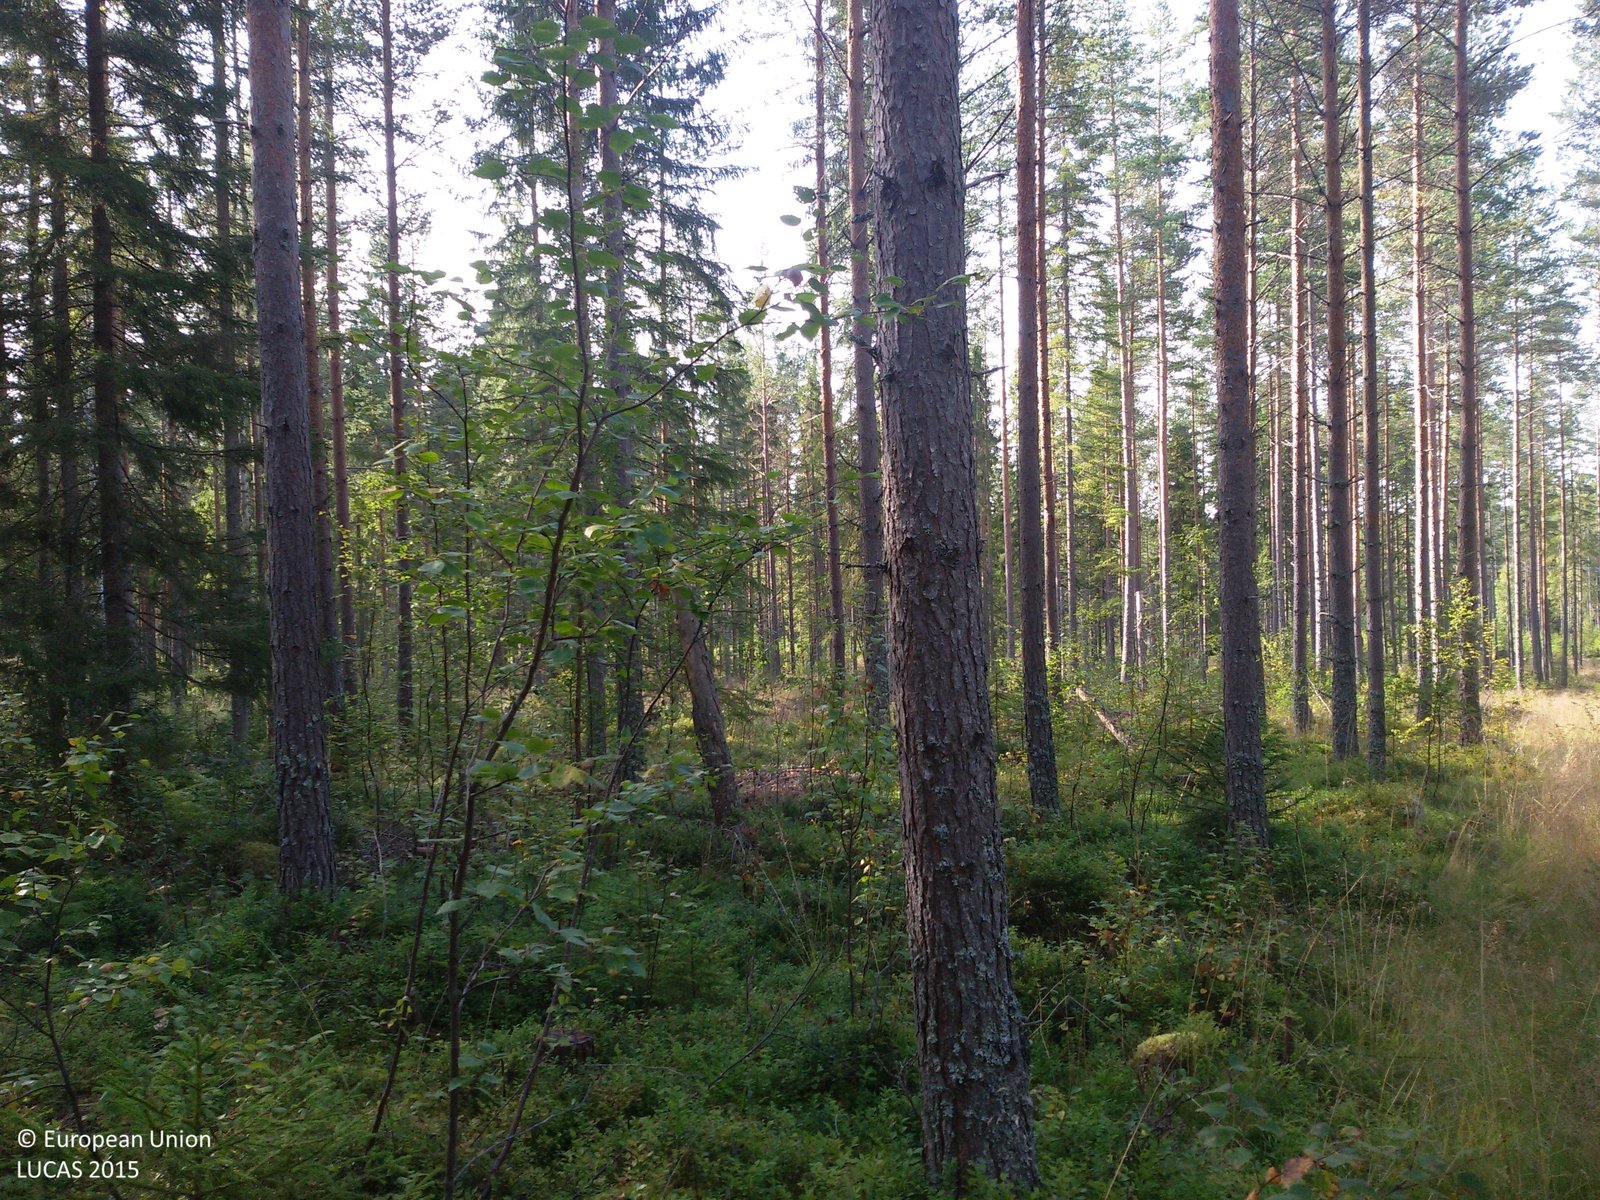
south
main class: Woodland
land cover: Pine dominated coniferous woodland
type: boreal forest
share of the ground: 50 - 75 %
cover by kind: coniferous forest trees 70 %, herbaceous plants 25 %, lichens and mosses 5 %
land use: Forestry
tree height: > 5 m
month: September
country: SE
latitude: 60.9573
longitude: 15.0275
